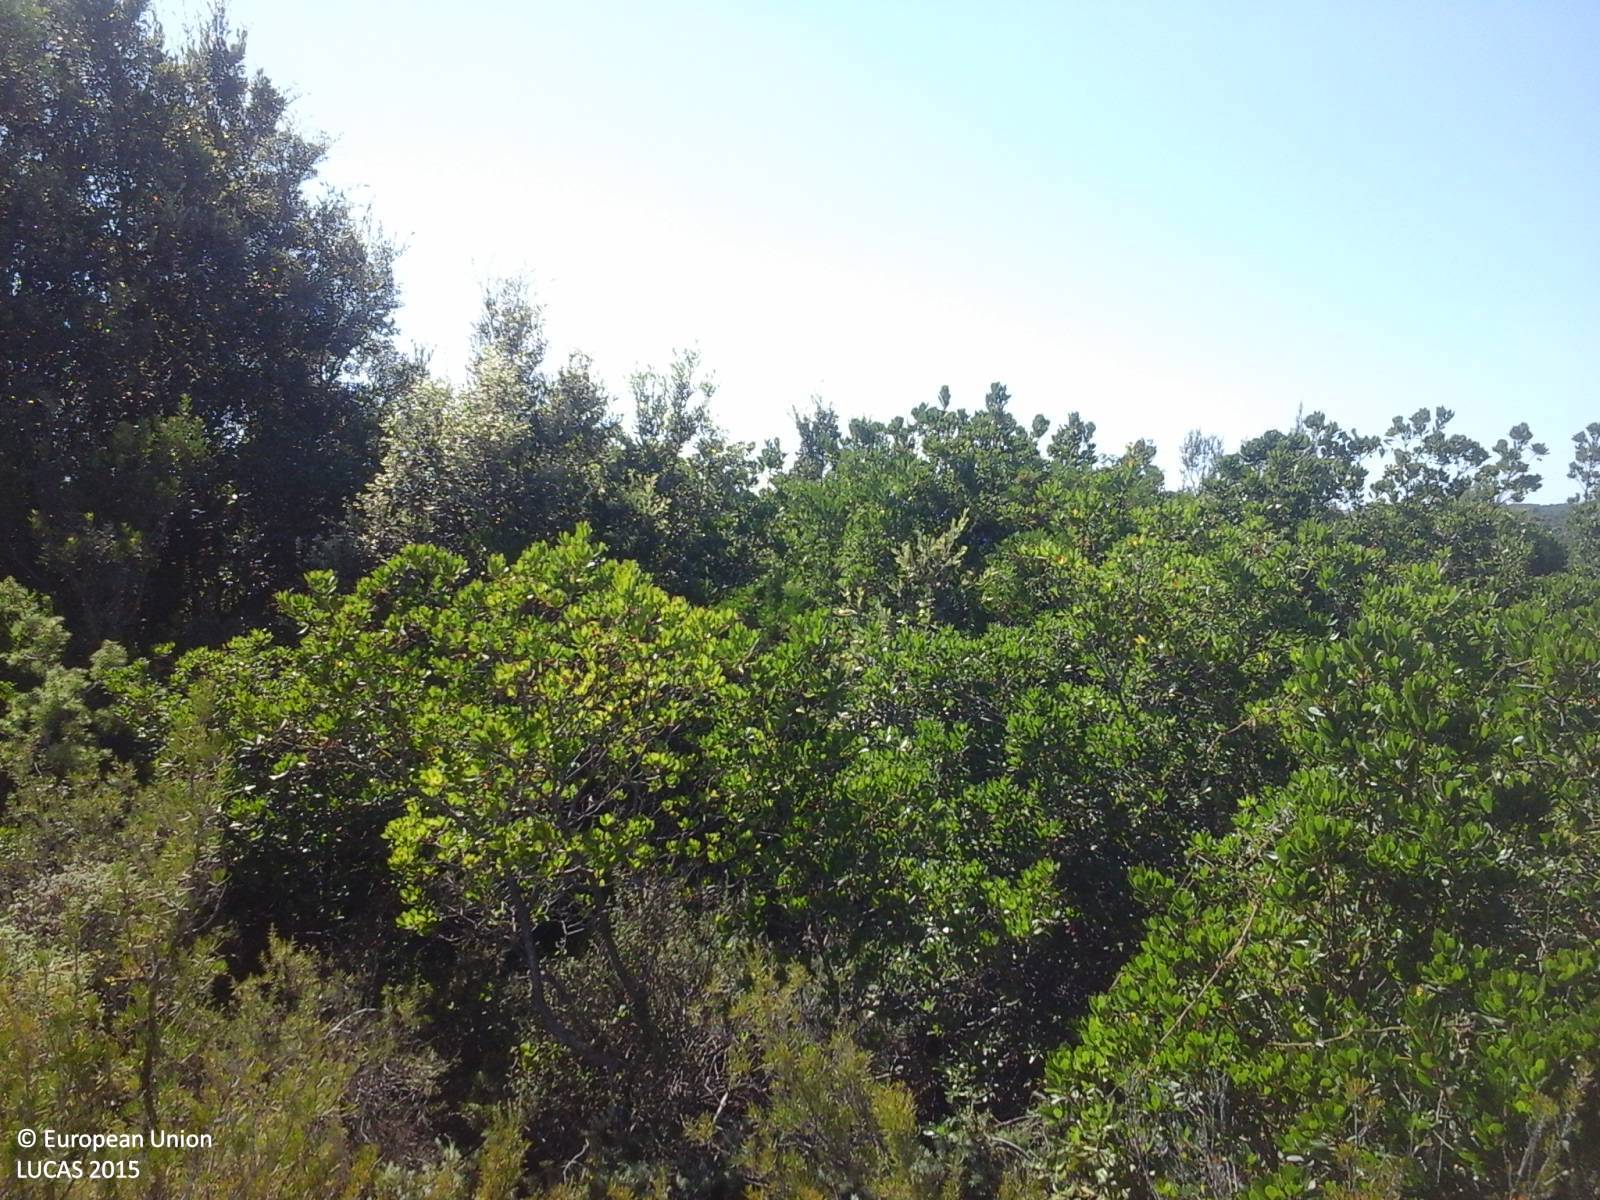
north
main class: Shrubland
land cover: Shrubland with sparse tree cover
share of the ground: > 75 %
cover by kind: shrubs 80 %, herbaceous plants 10 %, broadleaved forest trees 5 %, unconsolidated bare surface 5 %
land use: Agriculture (excluding fallow land and kitchen gardens)
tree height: > 5 m
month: August
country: IT
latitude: 39.6684
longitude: 9.4785
